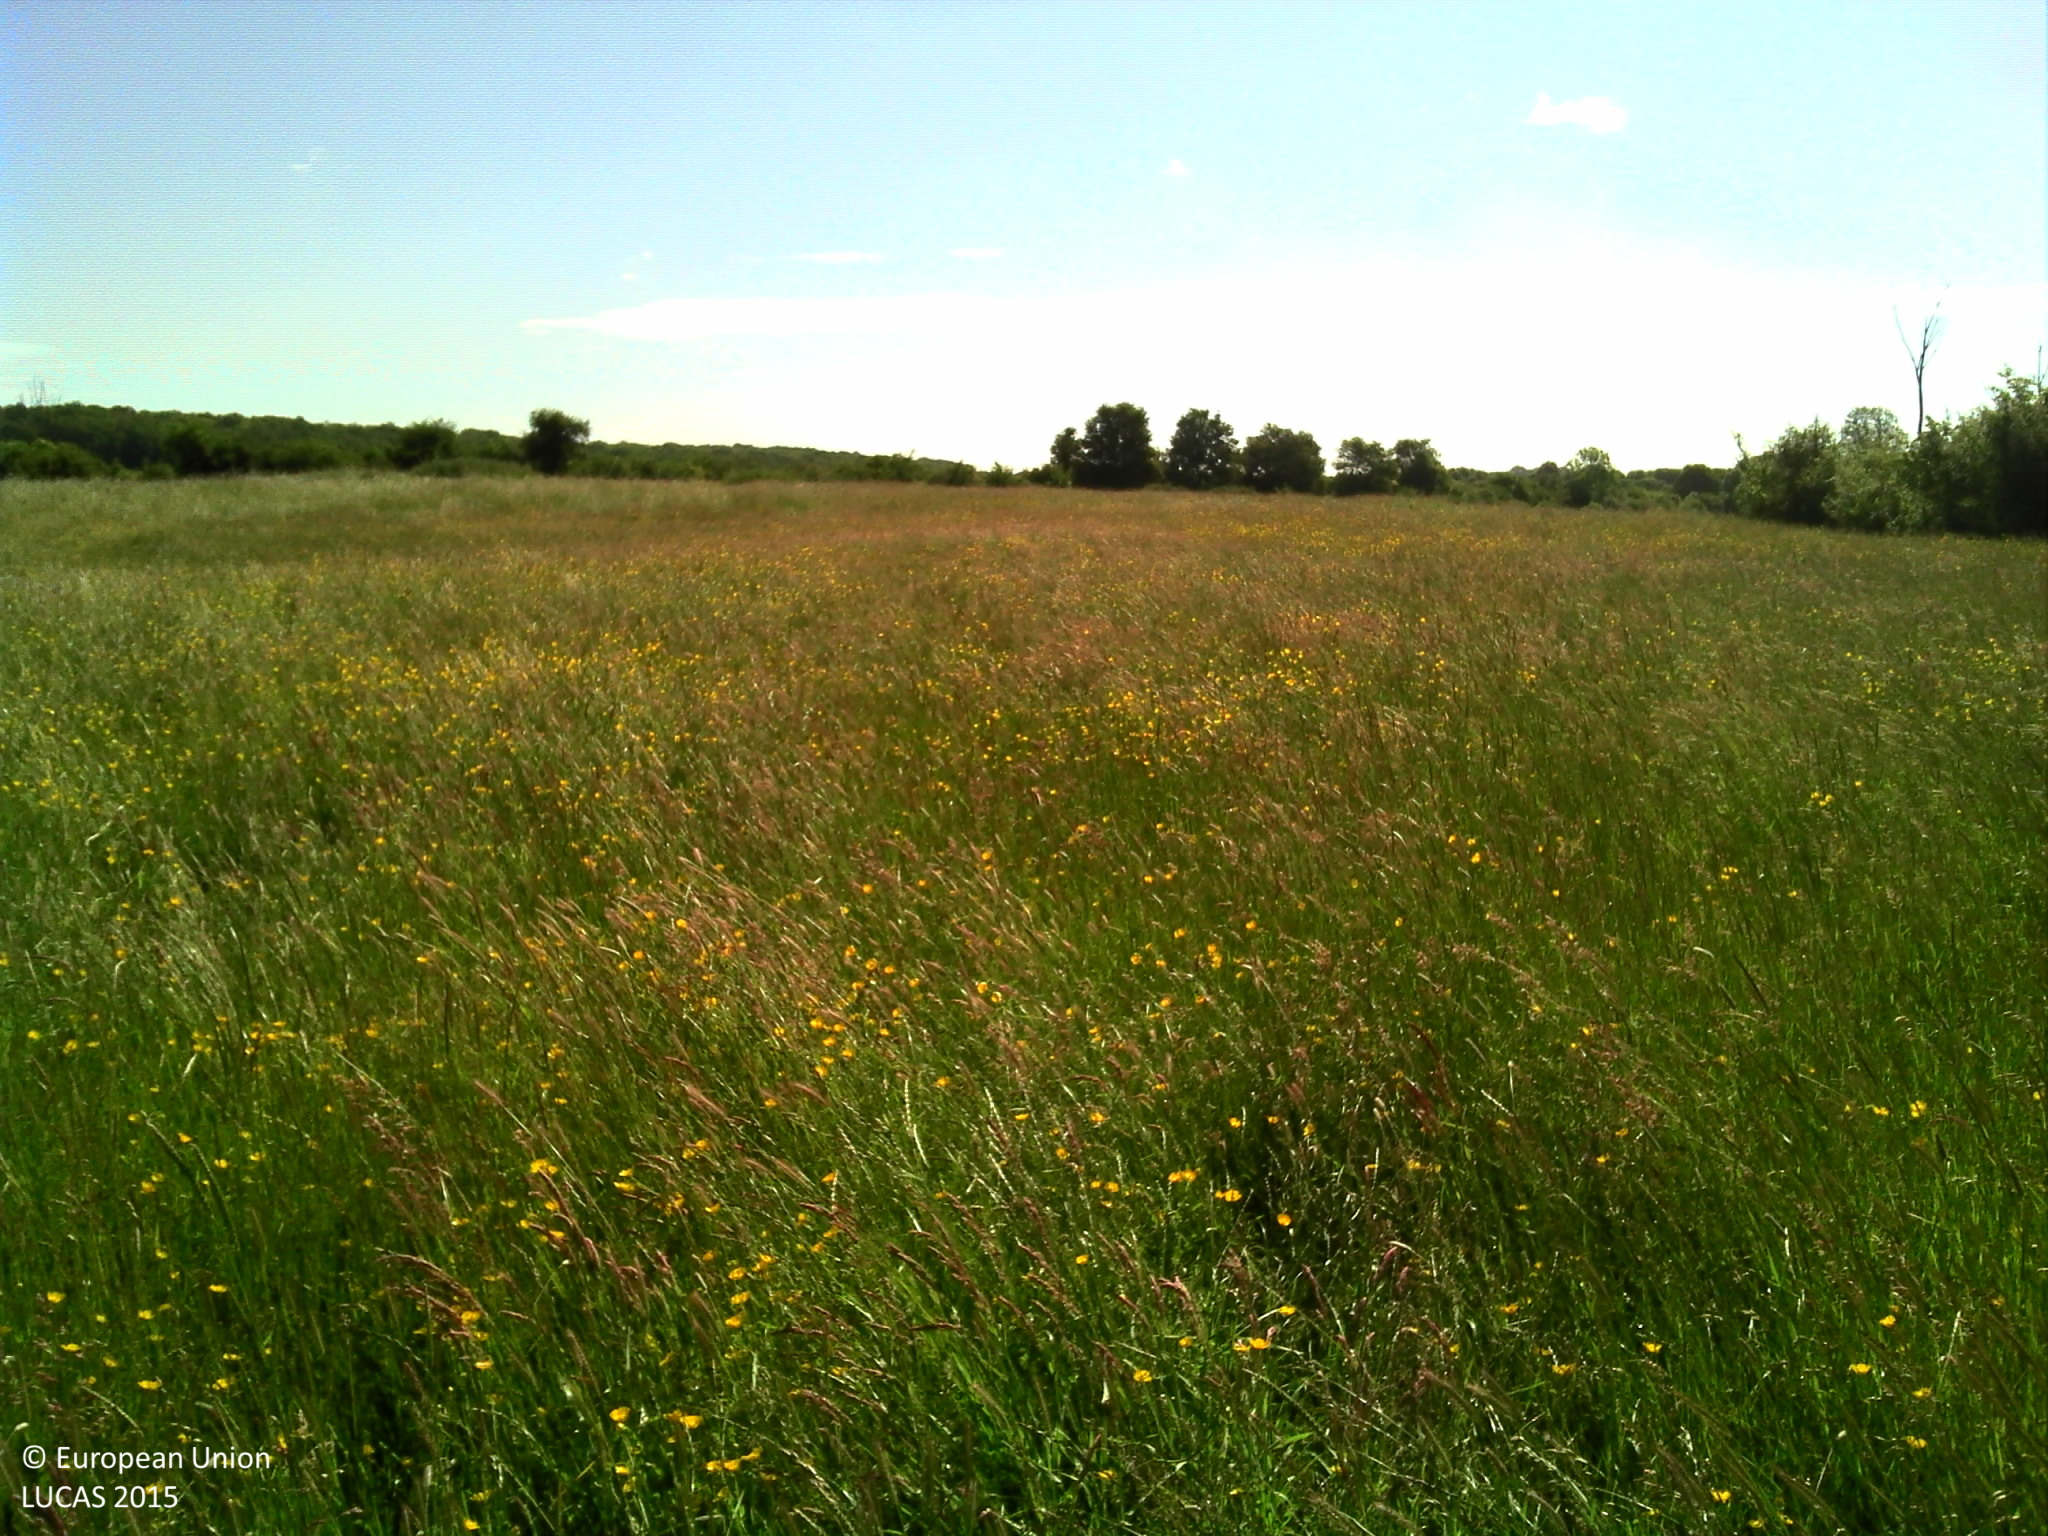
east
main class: Grassland
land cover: Grassland without tree/shrub cover
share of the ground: > 75 %
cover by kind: herbaceous plants 100 %
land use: Agriculture (excluding fallow land and kitchen gardens)
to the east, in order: Grassland without tree/shrub cover
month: June
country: FR
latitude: 46.9654
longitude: 2.9115
